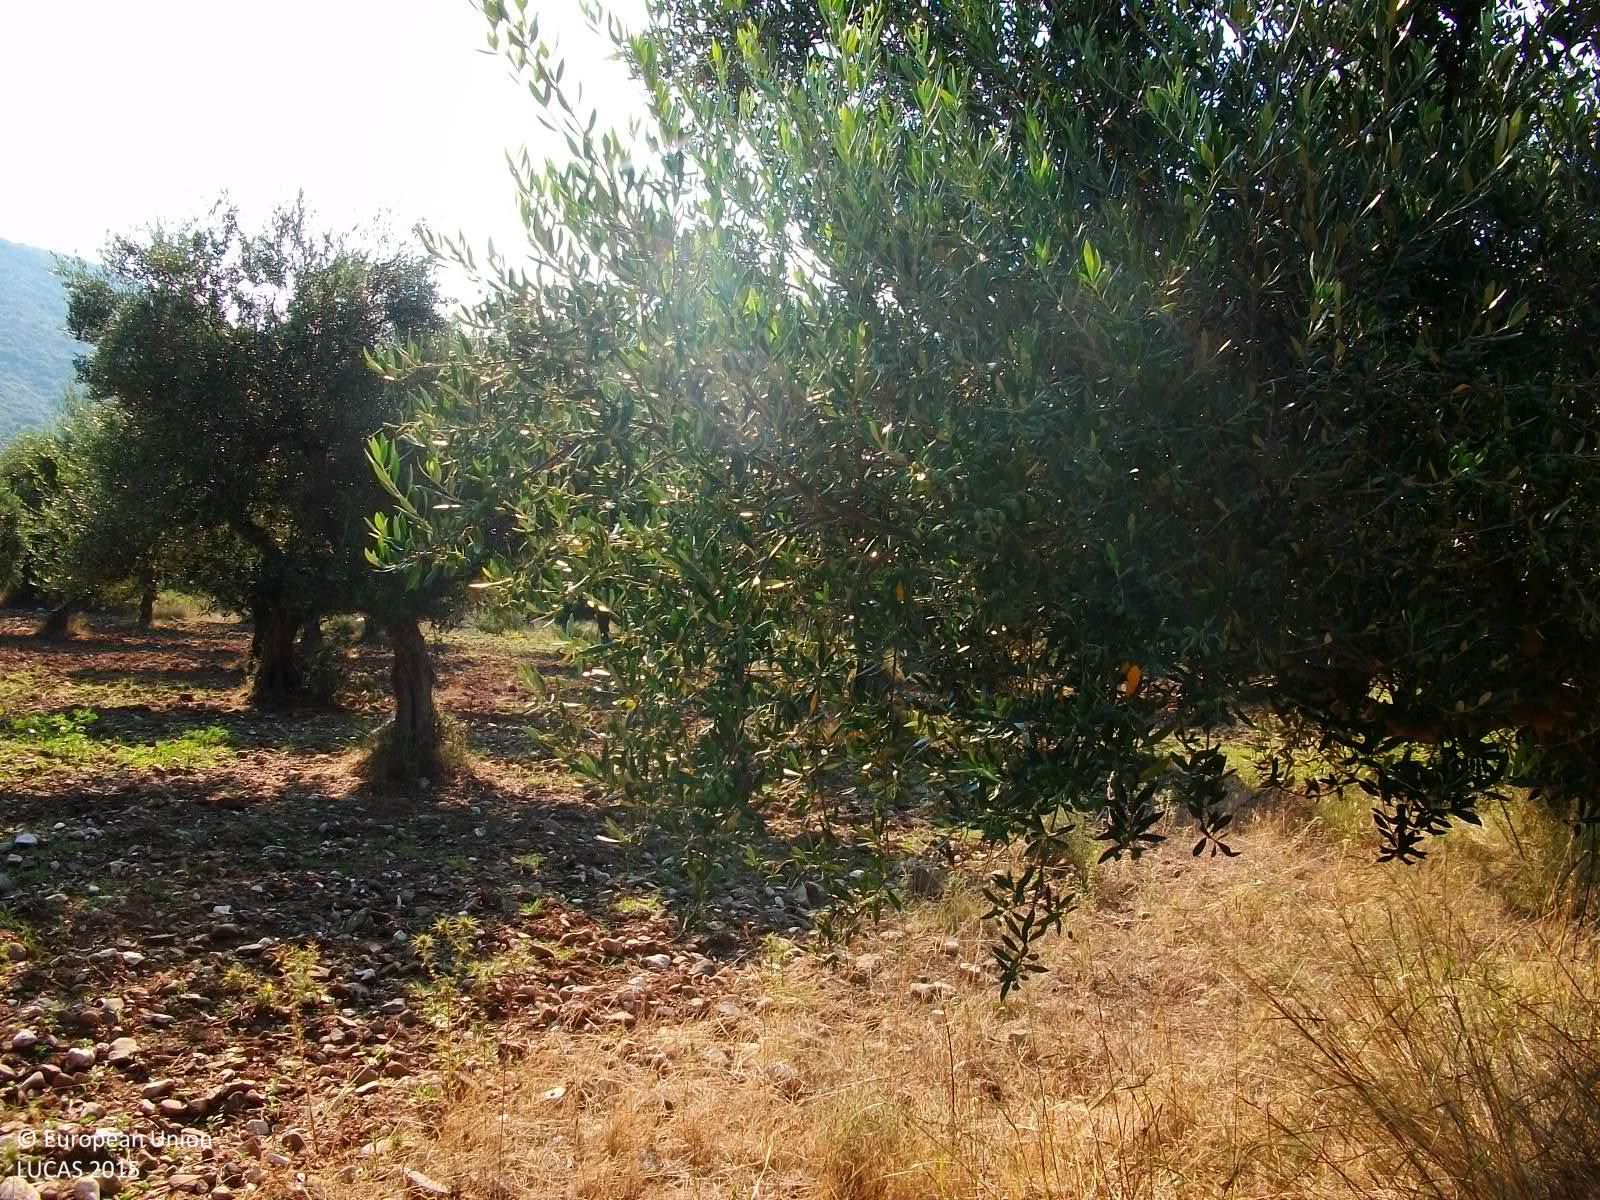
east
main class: Cropland
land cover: Olive groves
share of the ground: 50 - 75 %
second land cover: Spontaneously vegetated surfaces
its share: > 75 %
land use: Agriculture (excluding fallow land and kitchen gardens)
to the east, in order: Olive groves; Spontaneously vegetated surfaces; Grass margins; Tracks; Grass margins; Electric lines; Olive groves; Dry stone walls; Olive groves; Dry stone walls; Olive groves; Dry stone walls; Shruby margins; Olive groves; Shruby margins; Fences; Olive groves
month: July
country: GR
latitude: 37.3233
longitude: 21.9299
